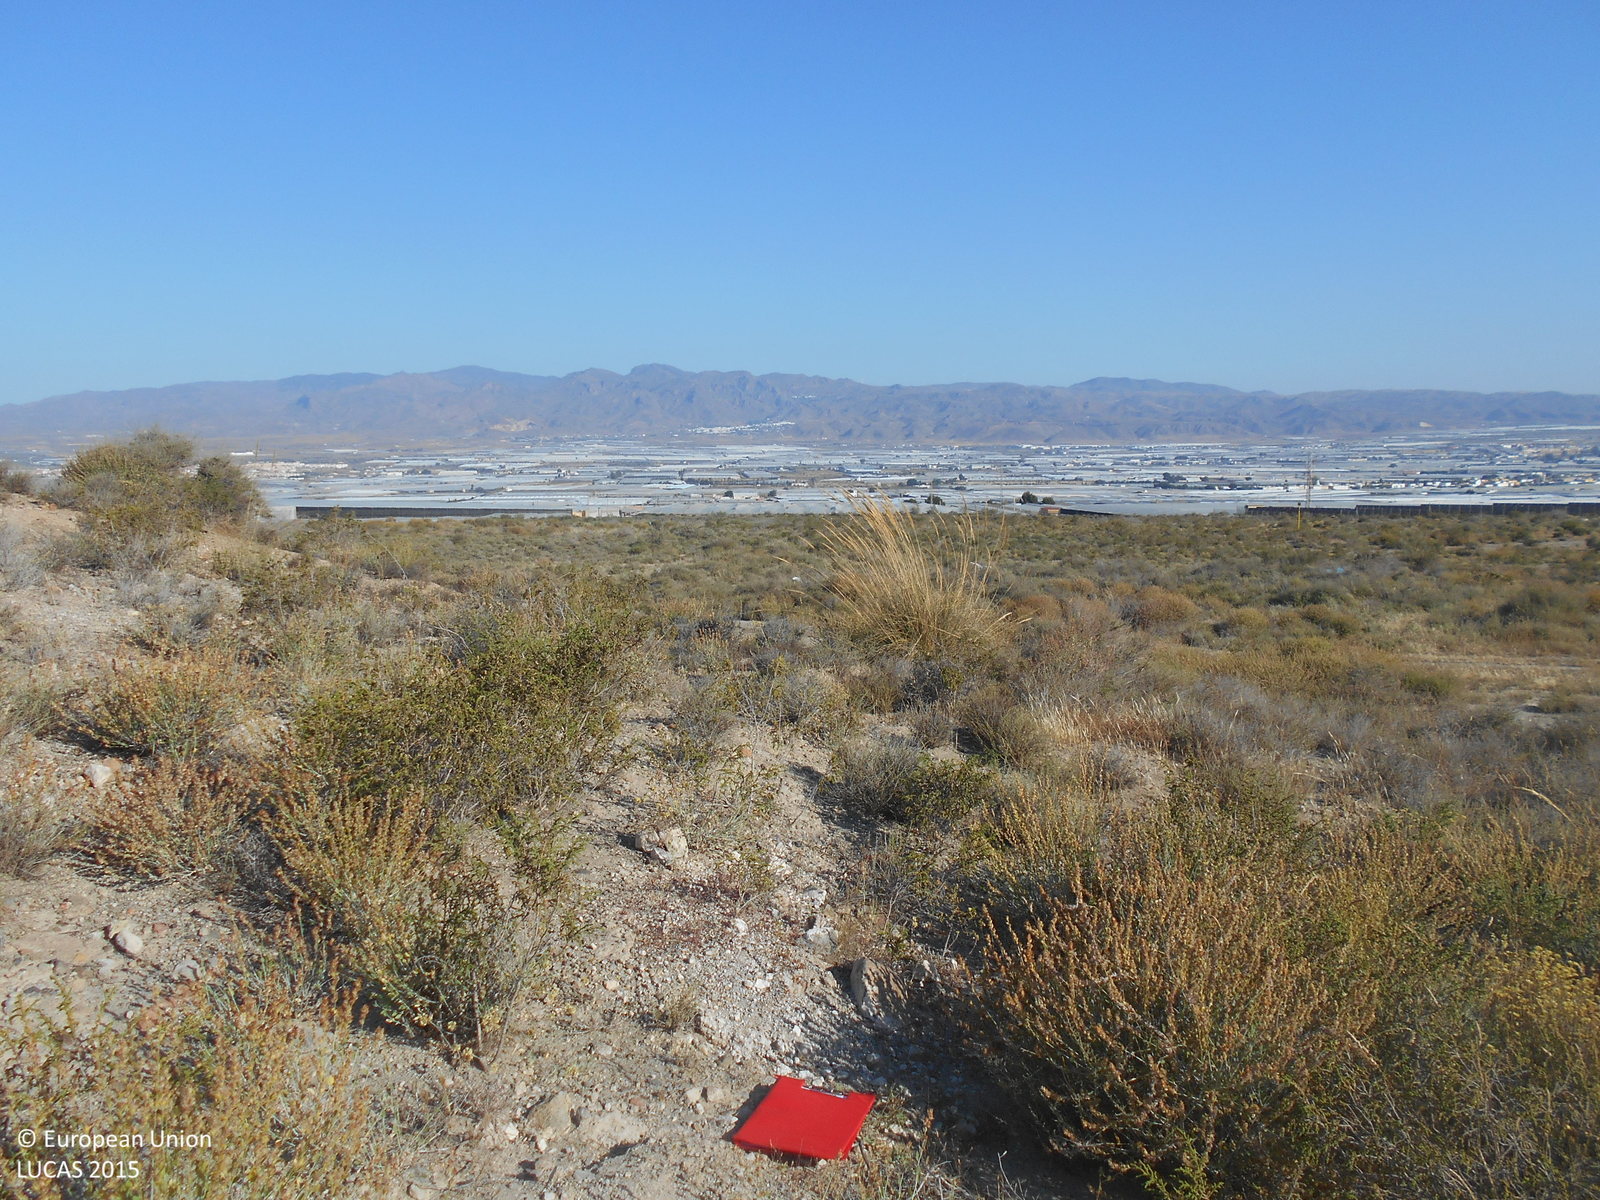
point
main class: Shrubland
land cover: Shrubland without tree cover
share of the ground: 25 - 50 %
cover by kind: unconsolidated bare surface 50 %, shrubs 40 %, herbaceous plants 10 %
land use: Semi-natural and natural areas not in use
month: May
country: ES
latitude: 36.8950
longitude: -2.1270
